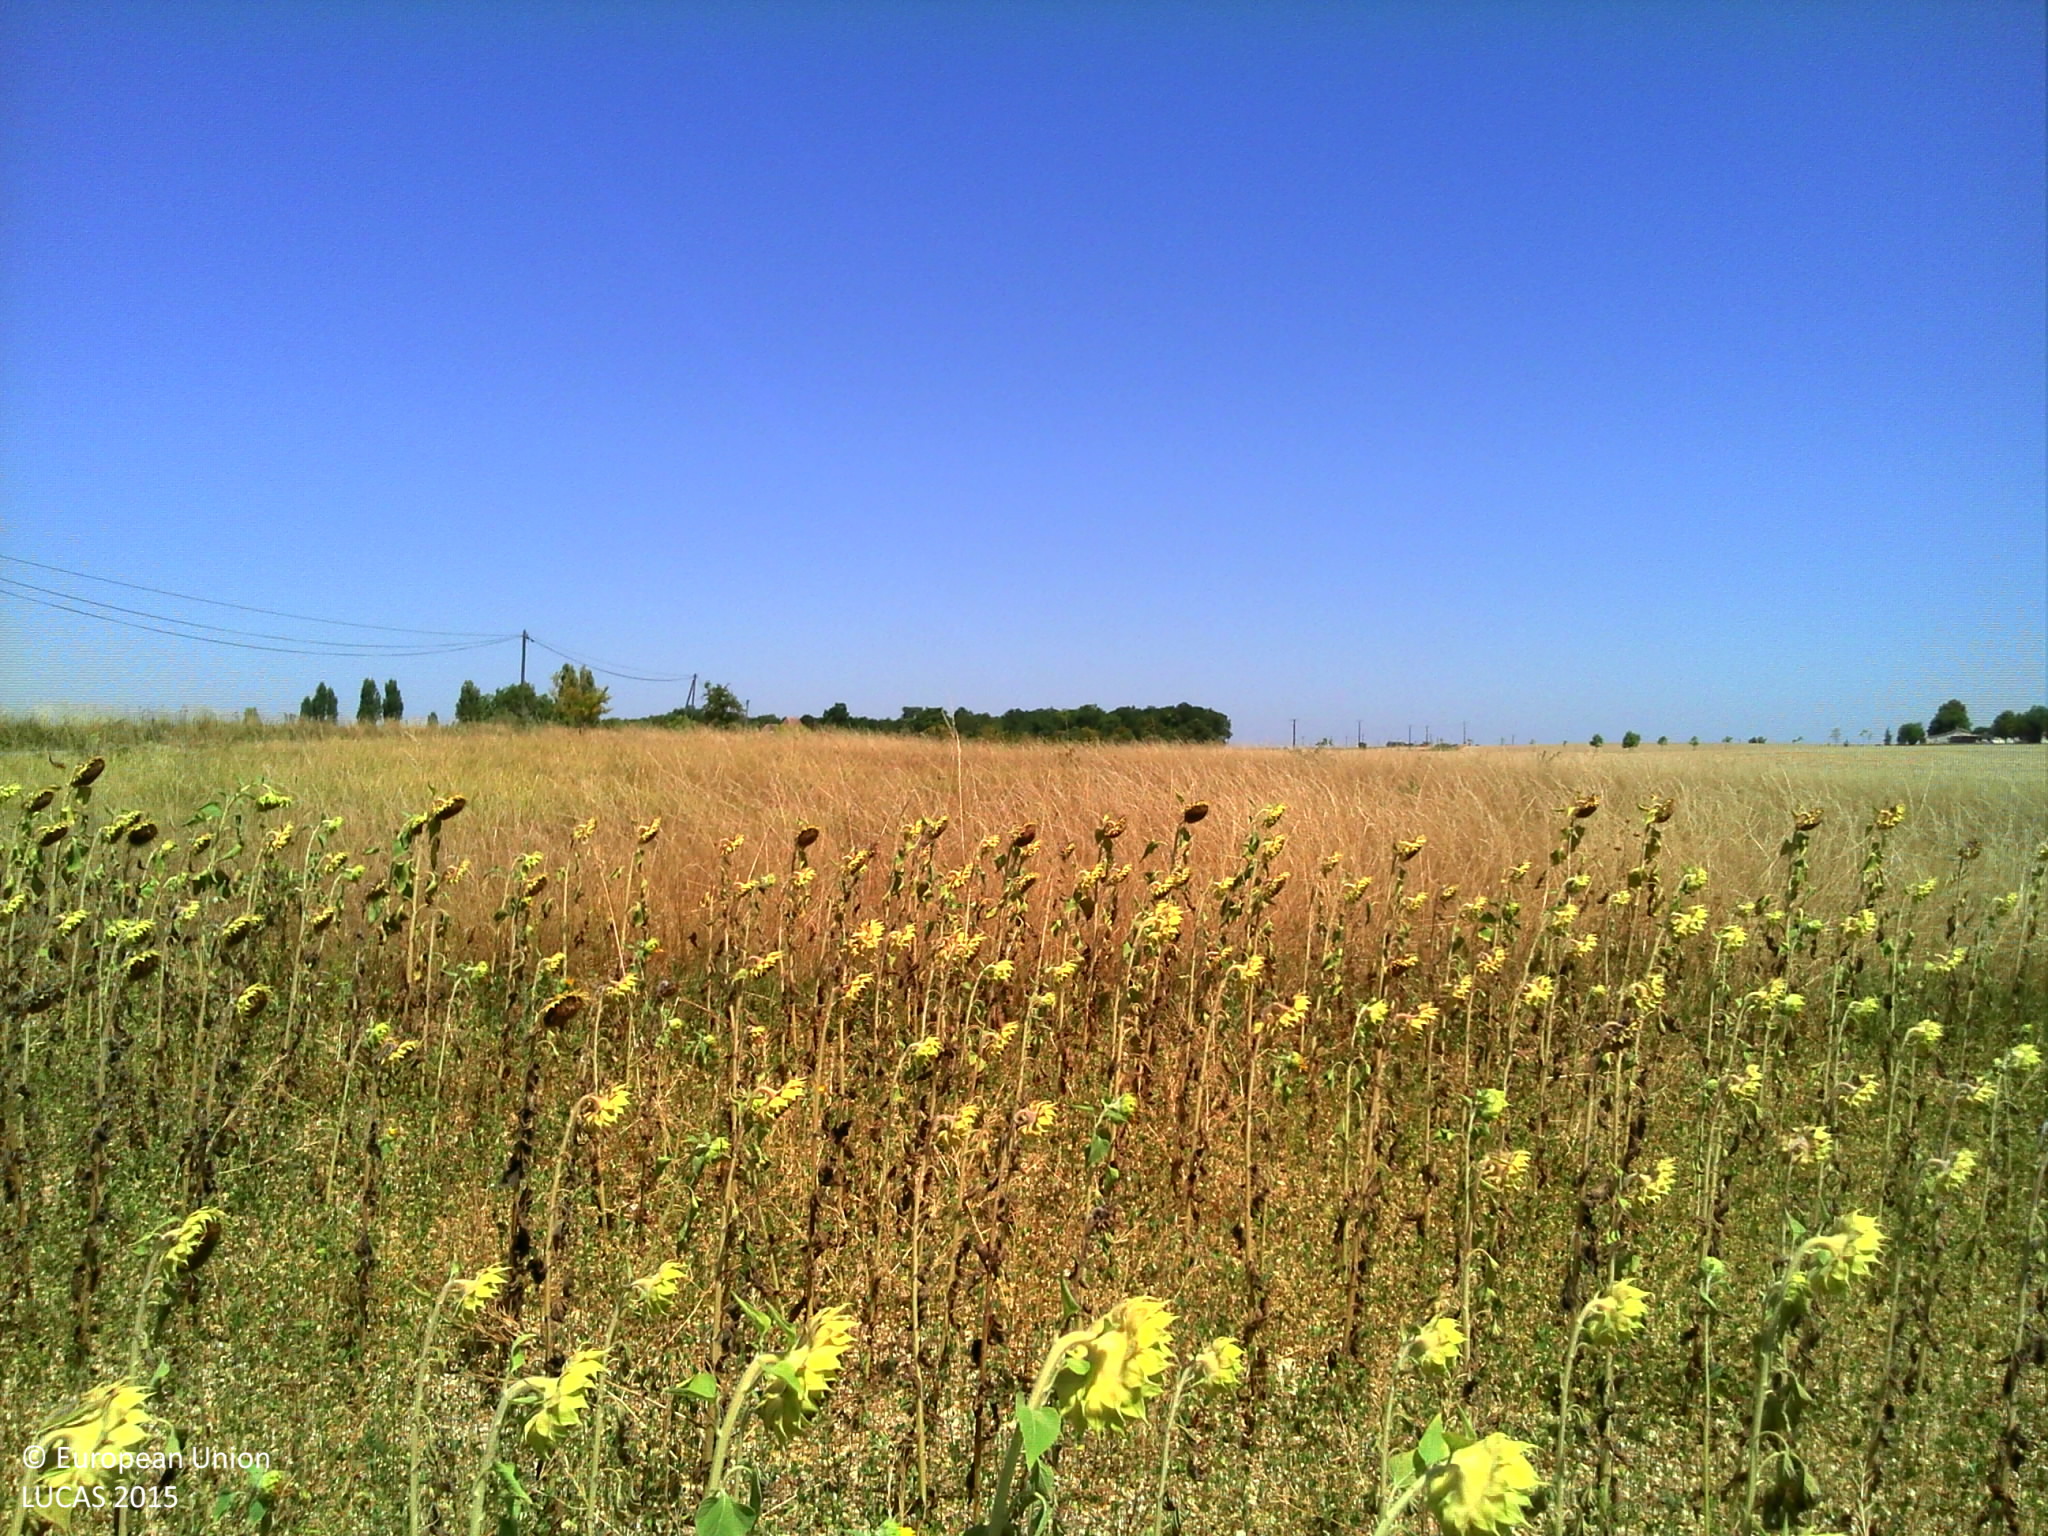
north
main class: Cropland
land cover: Sunflower
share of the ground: 25 - 50 %
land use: Agriculture (excluding fallow land and kitchen gardens)
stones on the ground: > 50 %
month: August
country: FR
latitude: 44.7403
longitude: 0.6083
